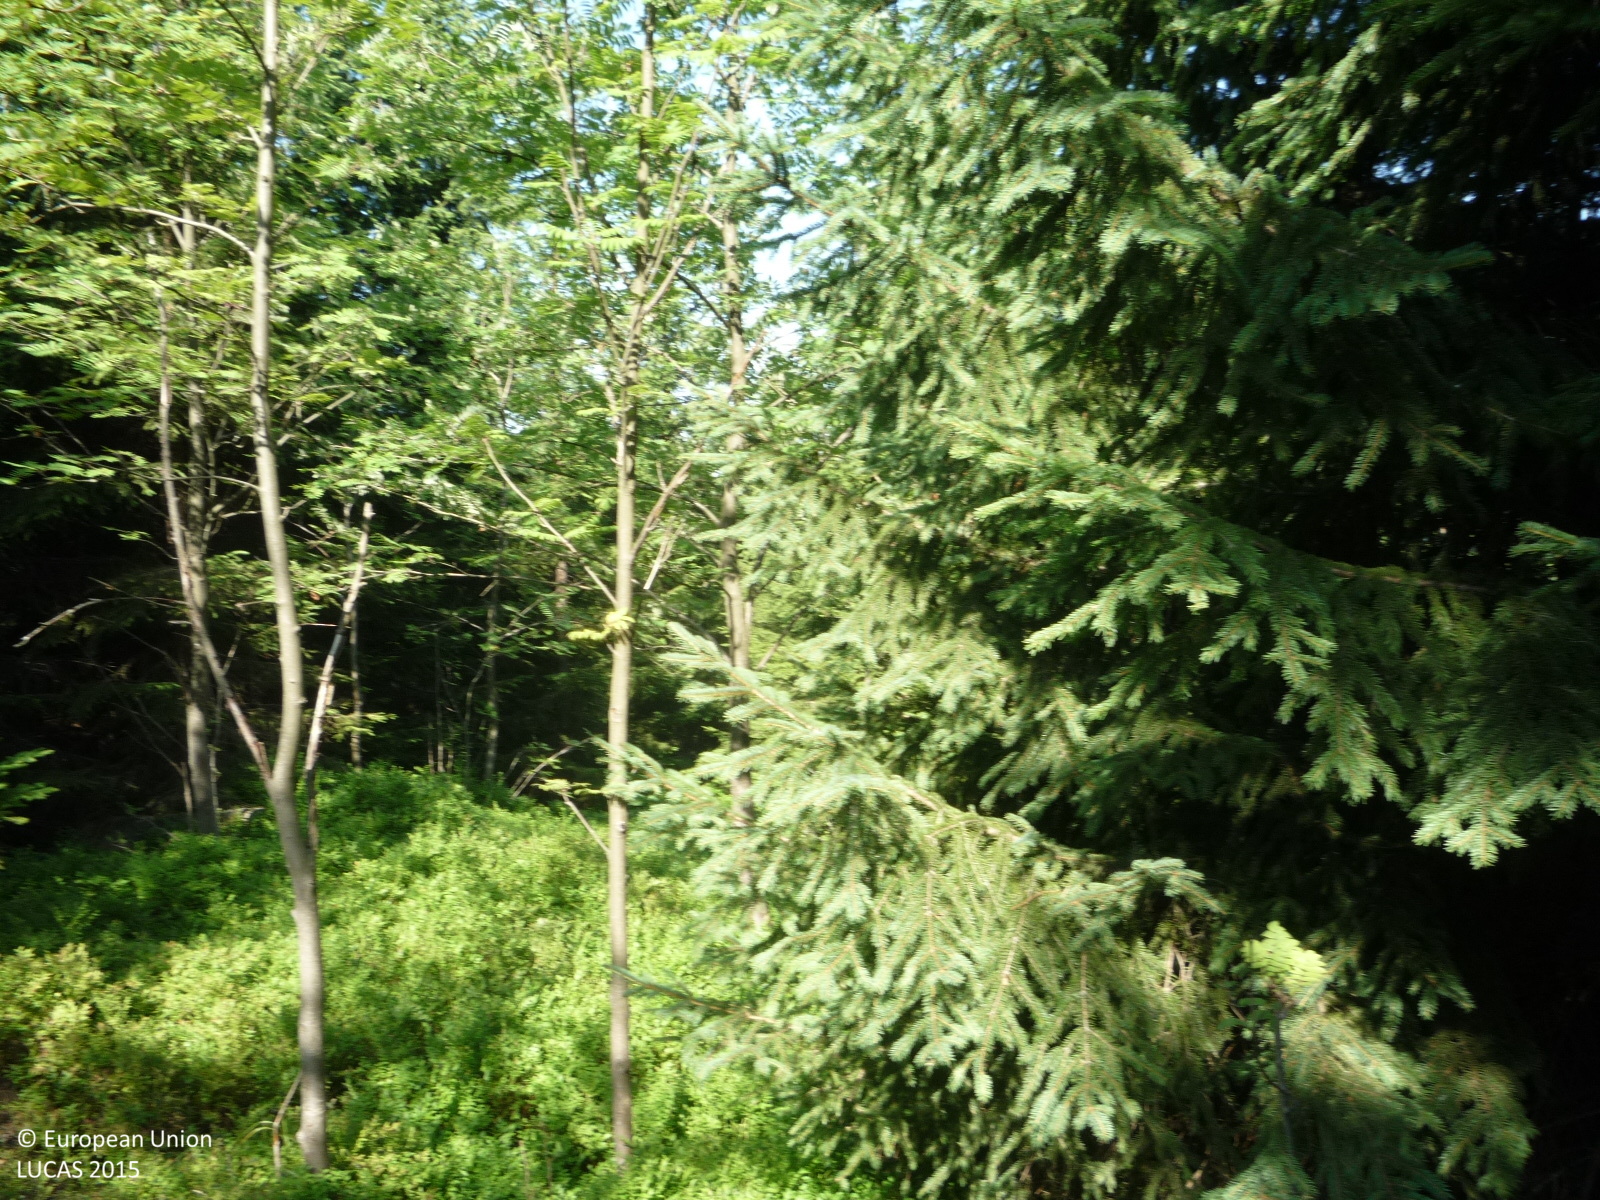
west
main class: Woodland
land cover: Spruce dominated coniferous woodland
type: hemiboreal forest and nemoral coniferous forest and mixed broadleaved-coniferous forest
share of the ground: > 75 %
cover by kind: coniferous forest trees 80 %, herbaceous plants 10 %, broadleaved forest trees 5 %, shrubs 5 %
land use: Forestry
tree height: > 5 m
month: August
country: CZ
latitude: 50.7130
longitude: 15.2293
